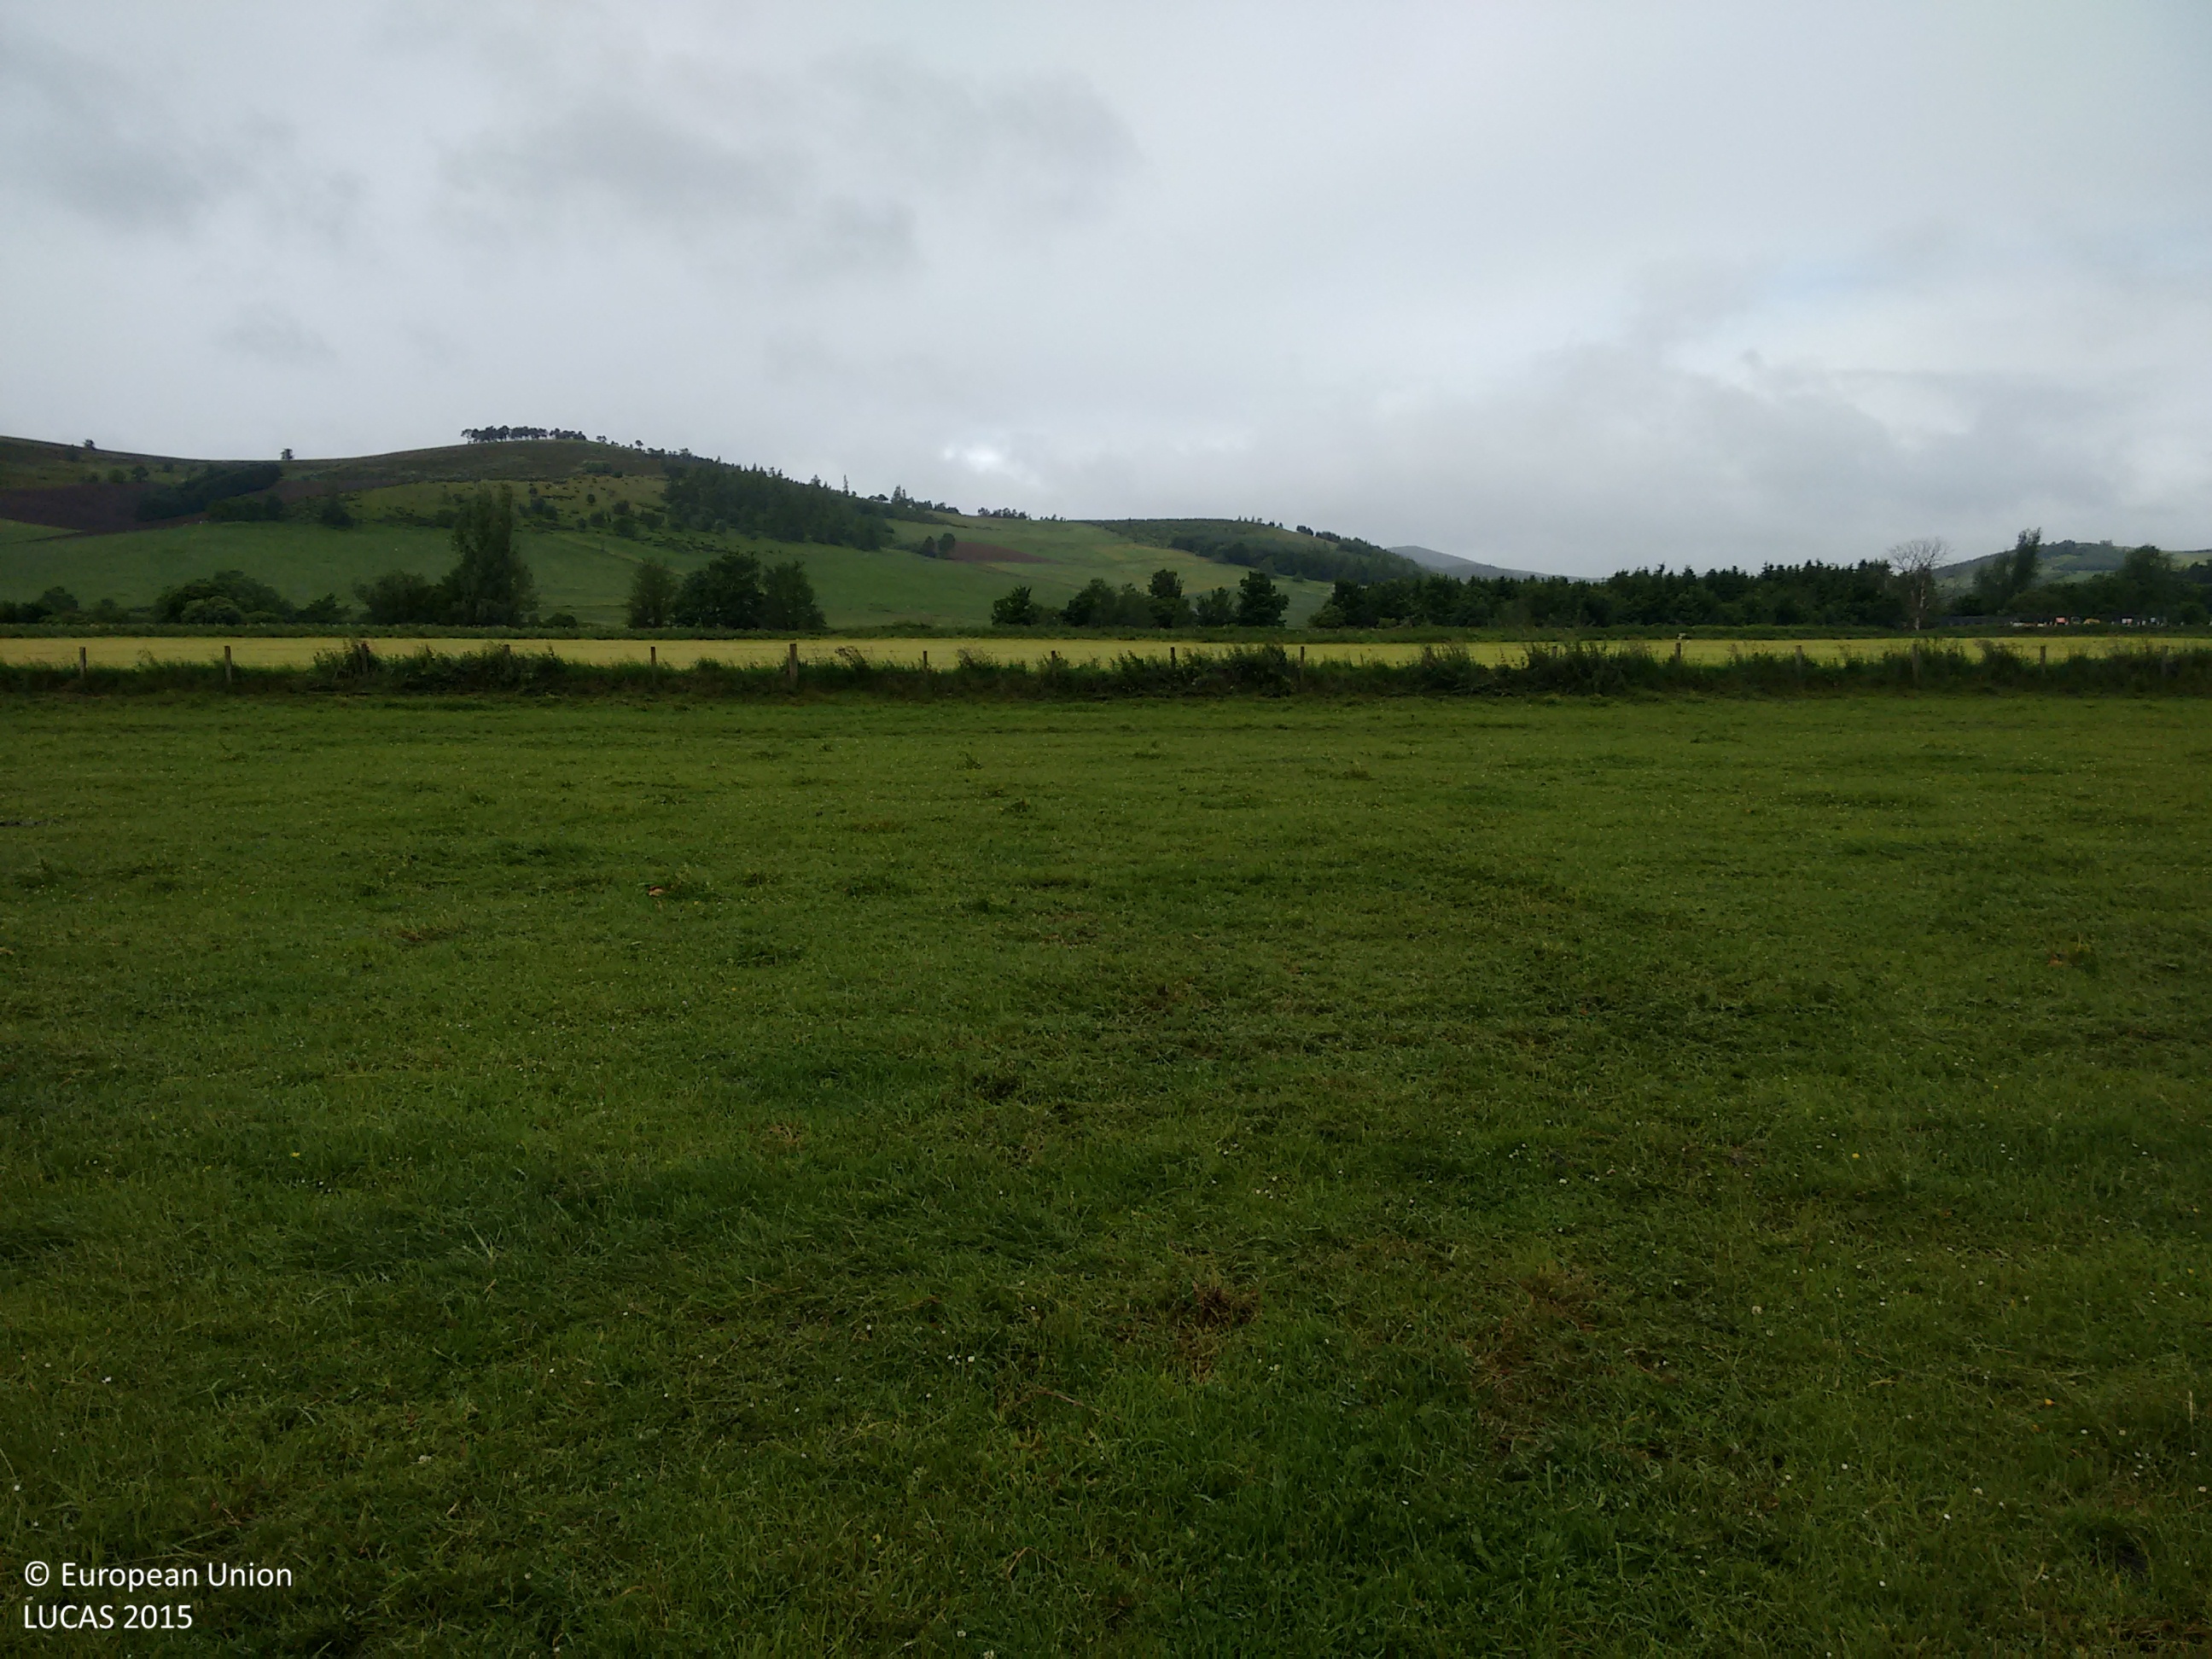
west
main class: Grassland
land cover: Grassland without tree/shrub cover
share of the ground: > 75 %
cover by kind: herbaceous plants 100 %
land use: Agriculture (excluding fallow land and kitchen gardens)
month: July
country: GB
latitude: 57.2087
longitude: -2.9249
